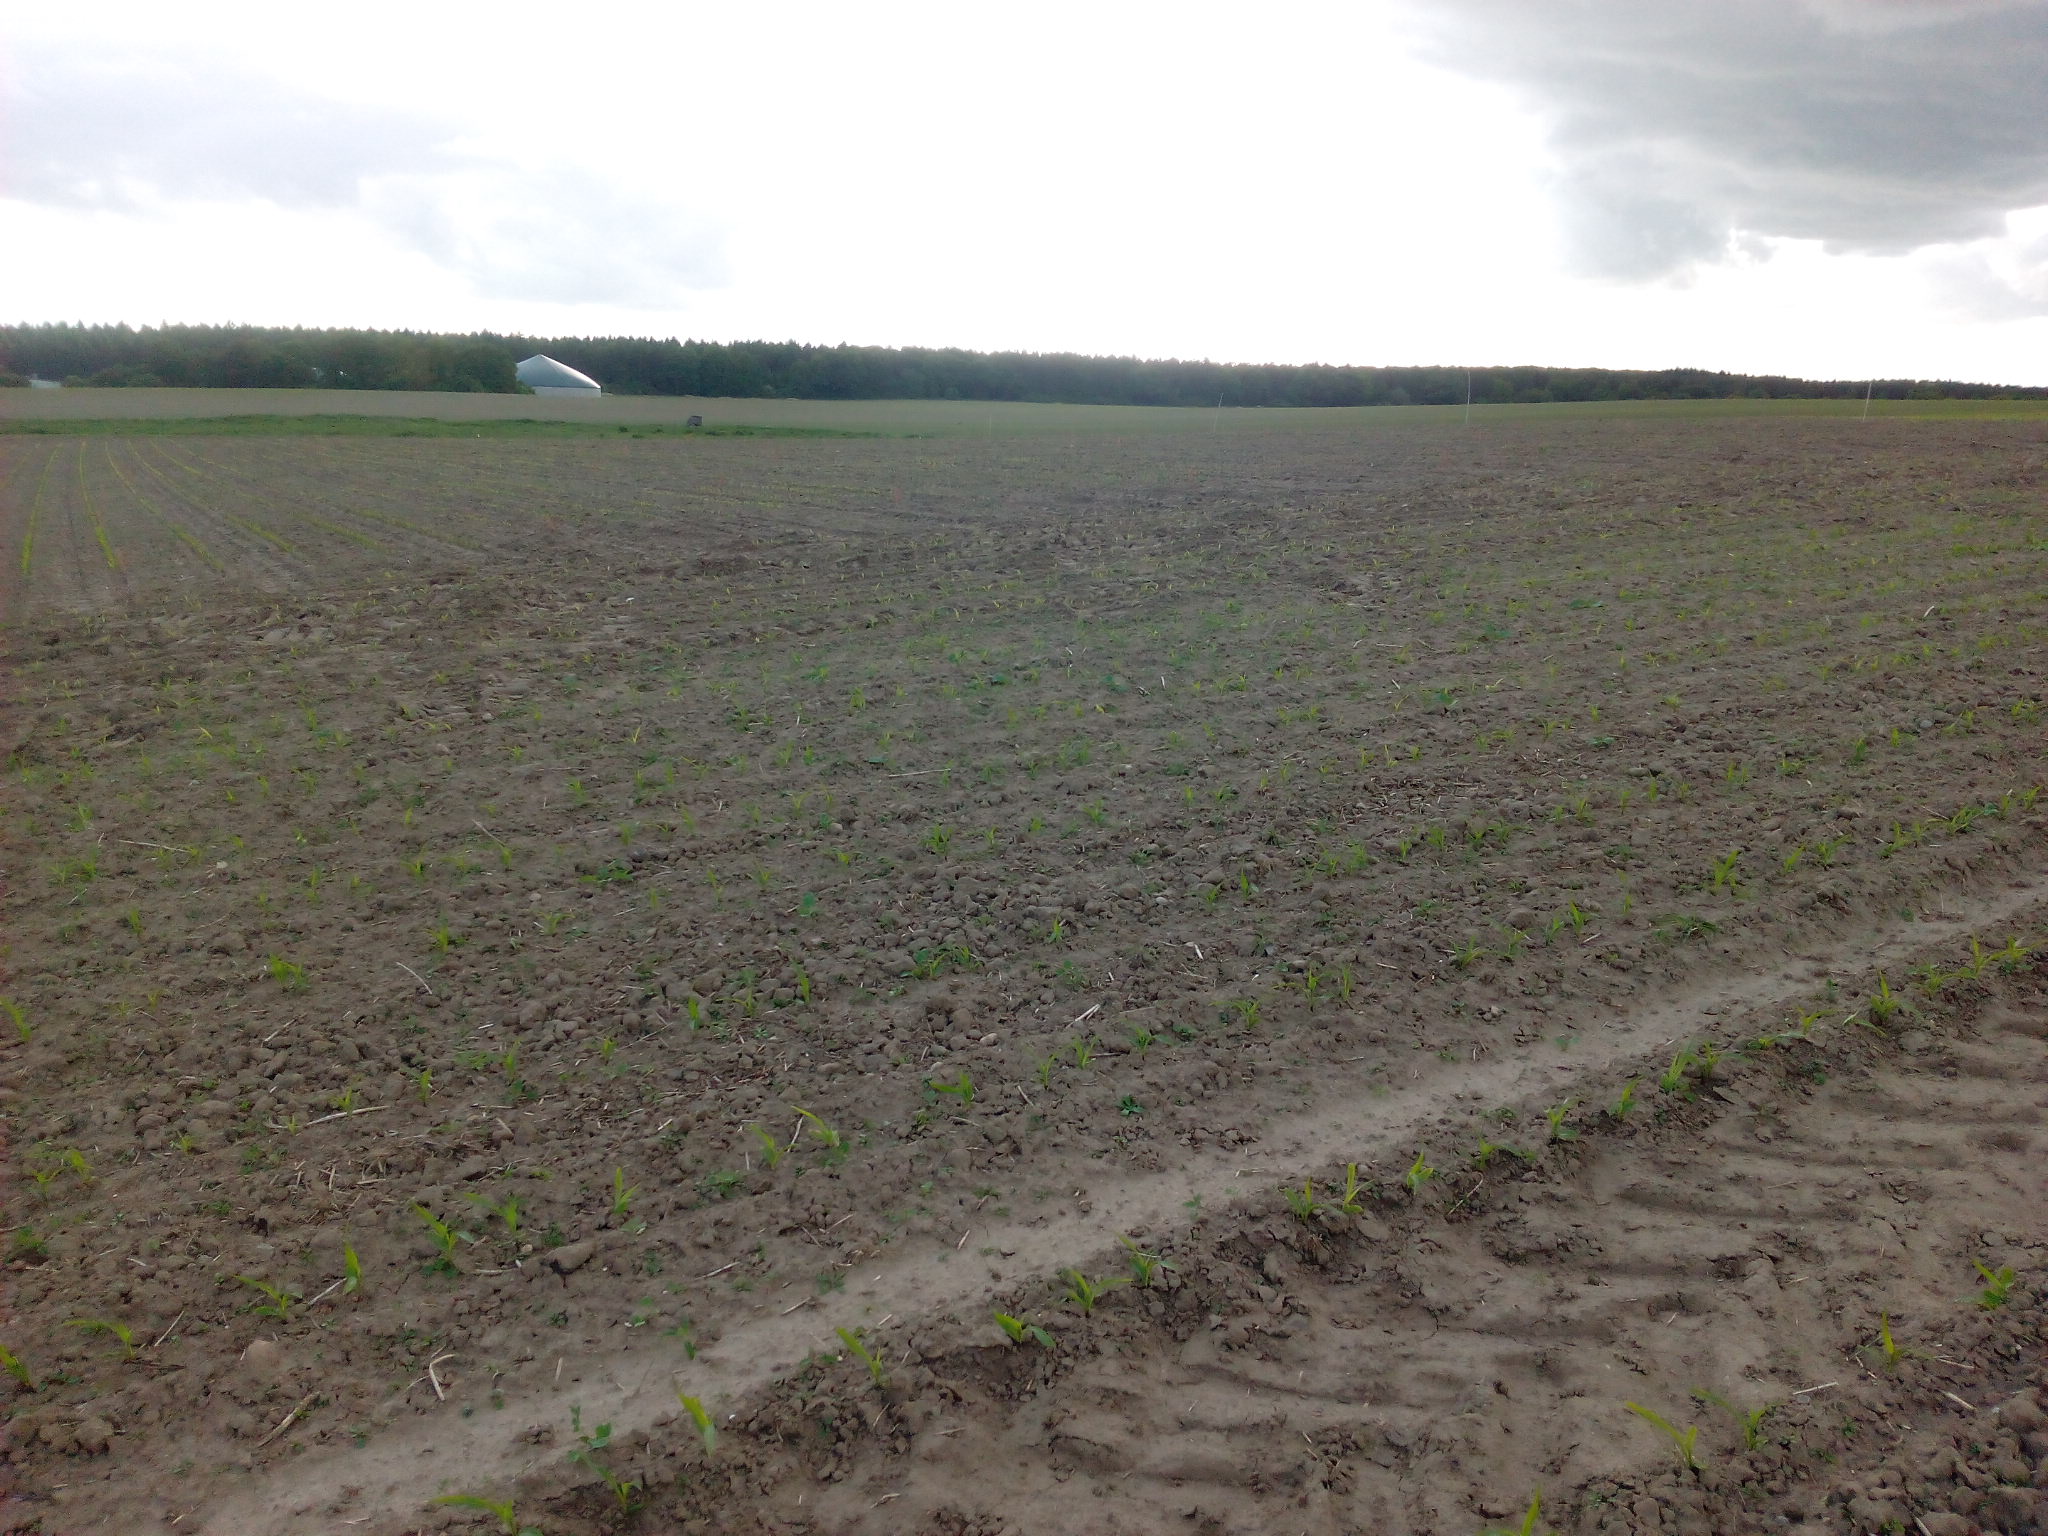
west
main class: Cropland
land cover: Maize
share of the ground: < 10 %
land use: Agriculture (excluding fallow land and kitchen gardens)
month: May
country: DE
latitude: 53.7718
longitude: 13.2616
